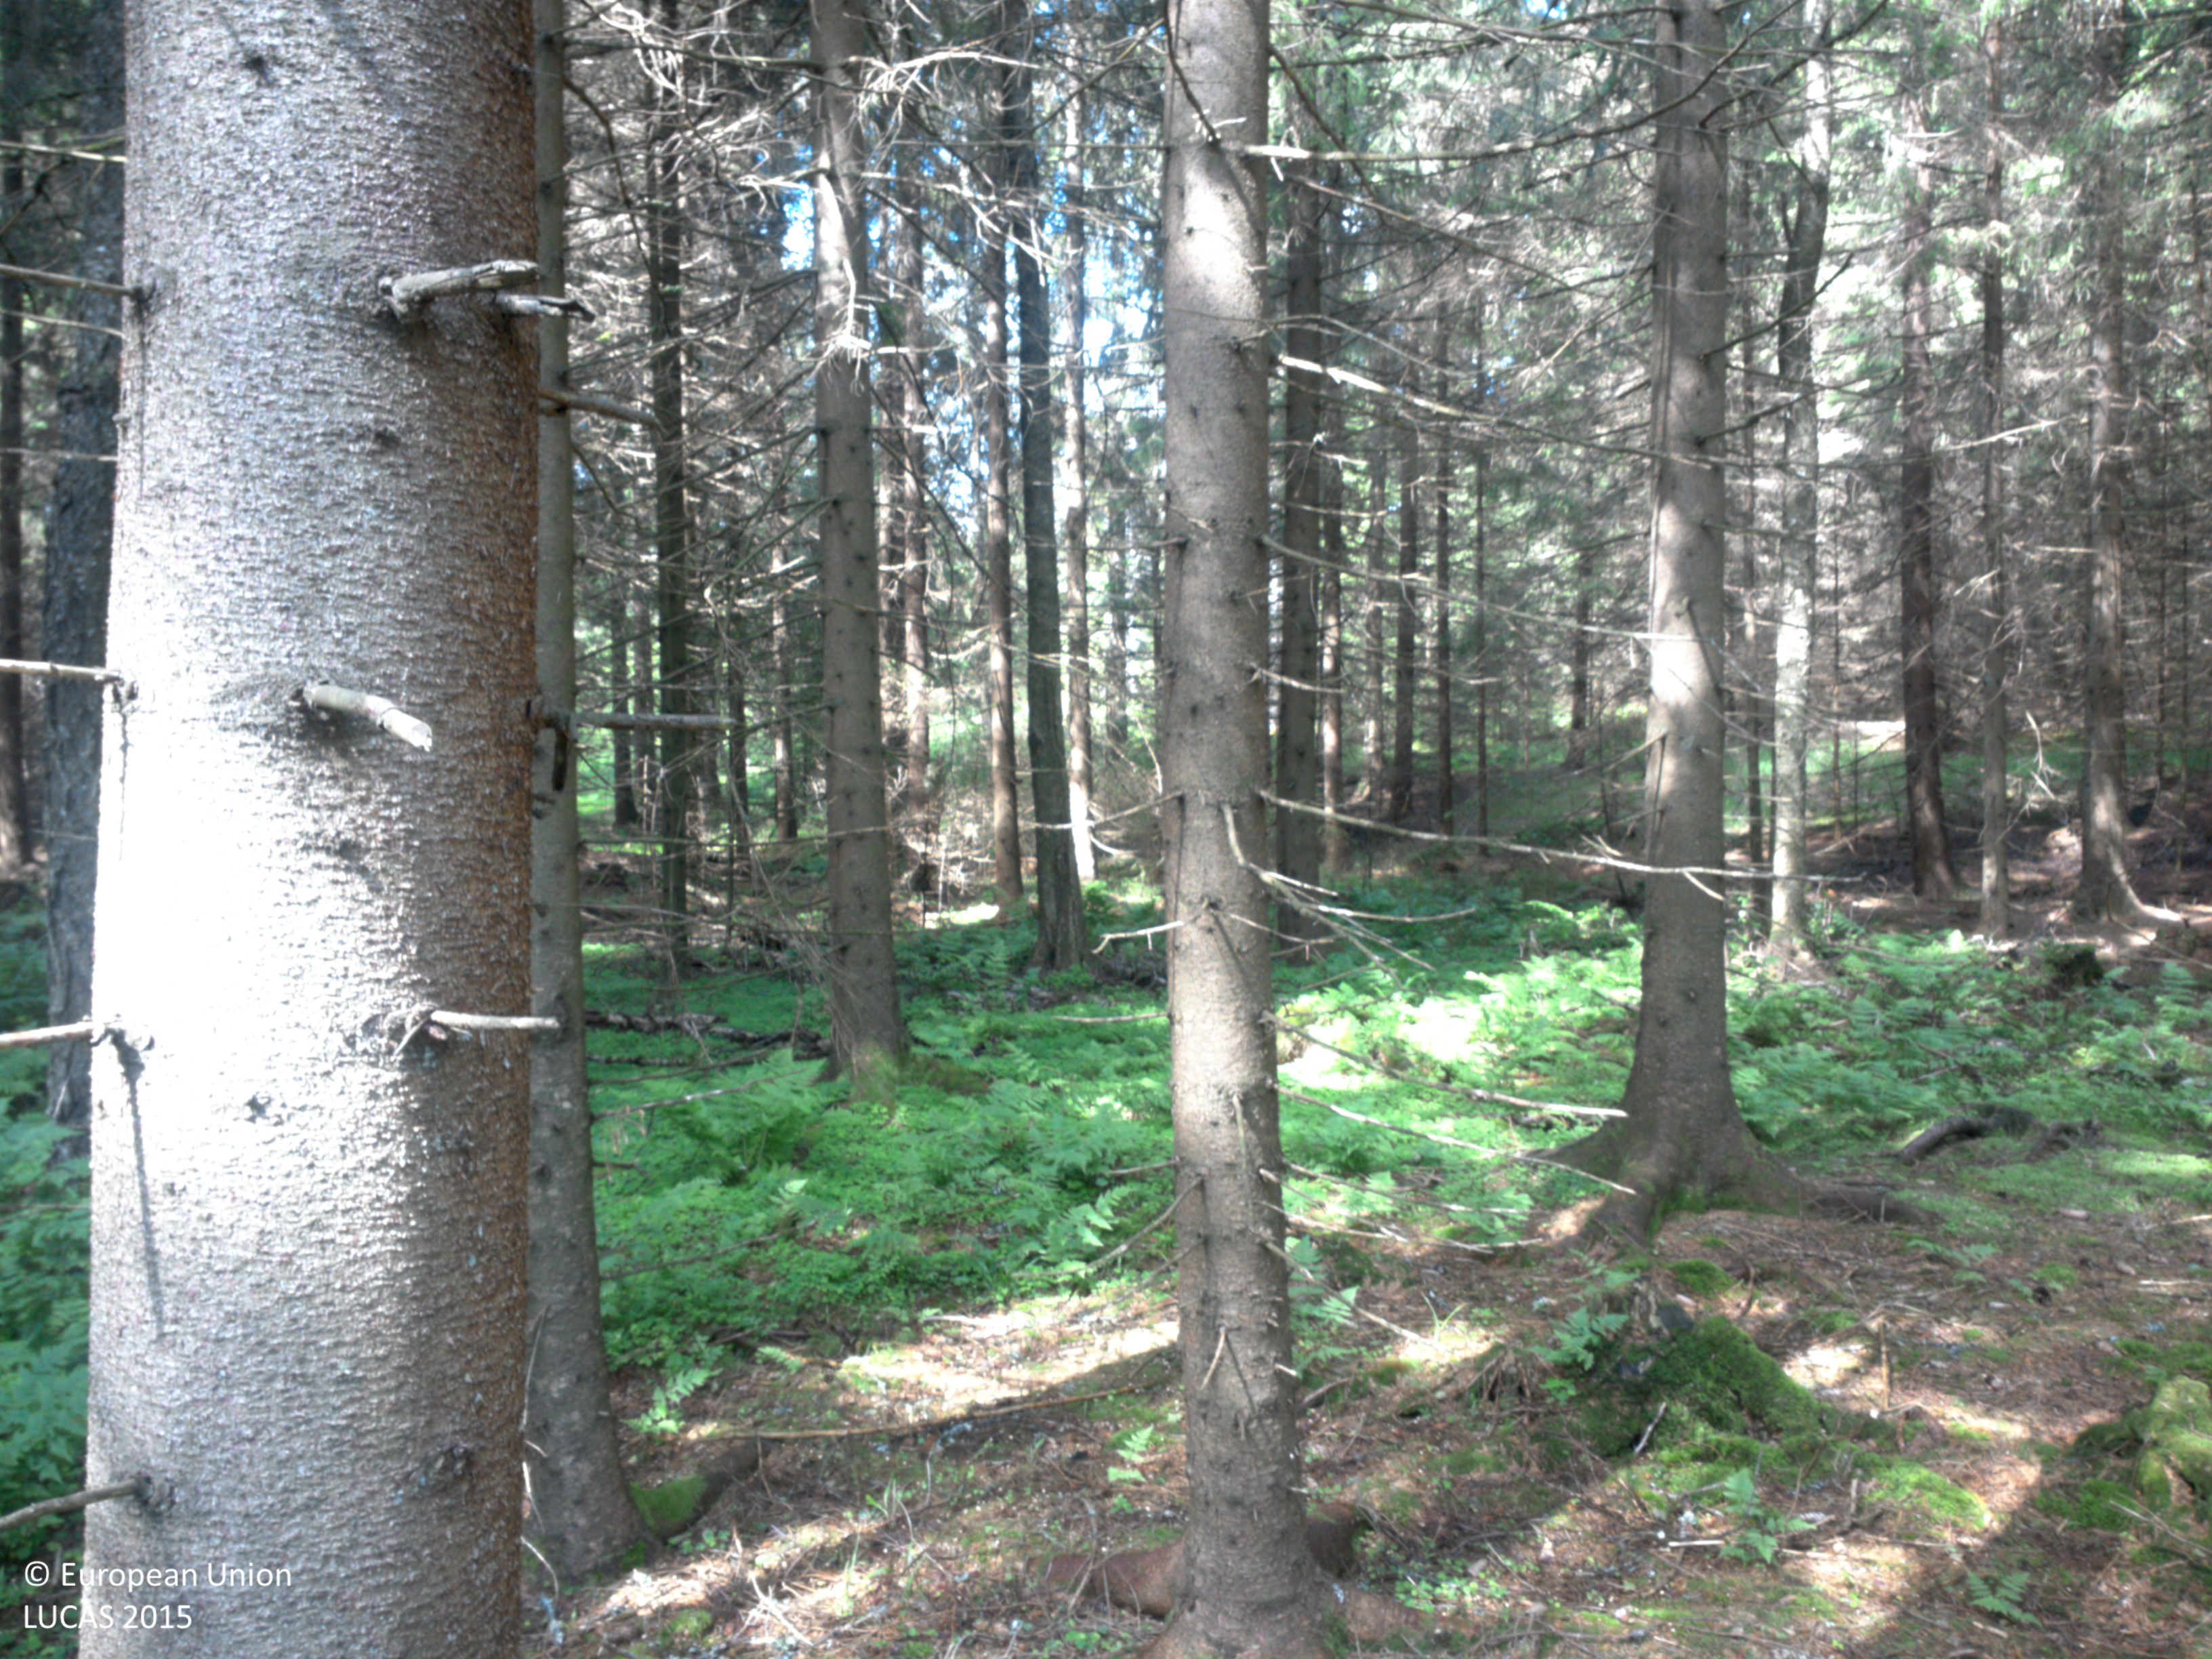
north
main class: Woodland
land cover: Spruce dominated coniferous woodland
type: boreal forest
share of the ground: > 75 %
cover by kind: coniferous forest trees 90 %, lichens and mosses 10 %
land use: Forestry
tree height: > 5 m
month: June
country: SE
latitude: 58.7676
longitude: 11.6044
